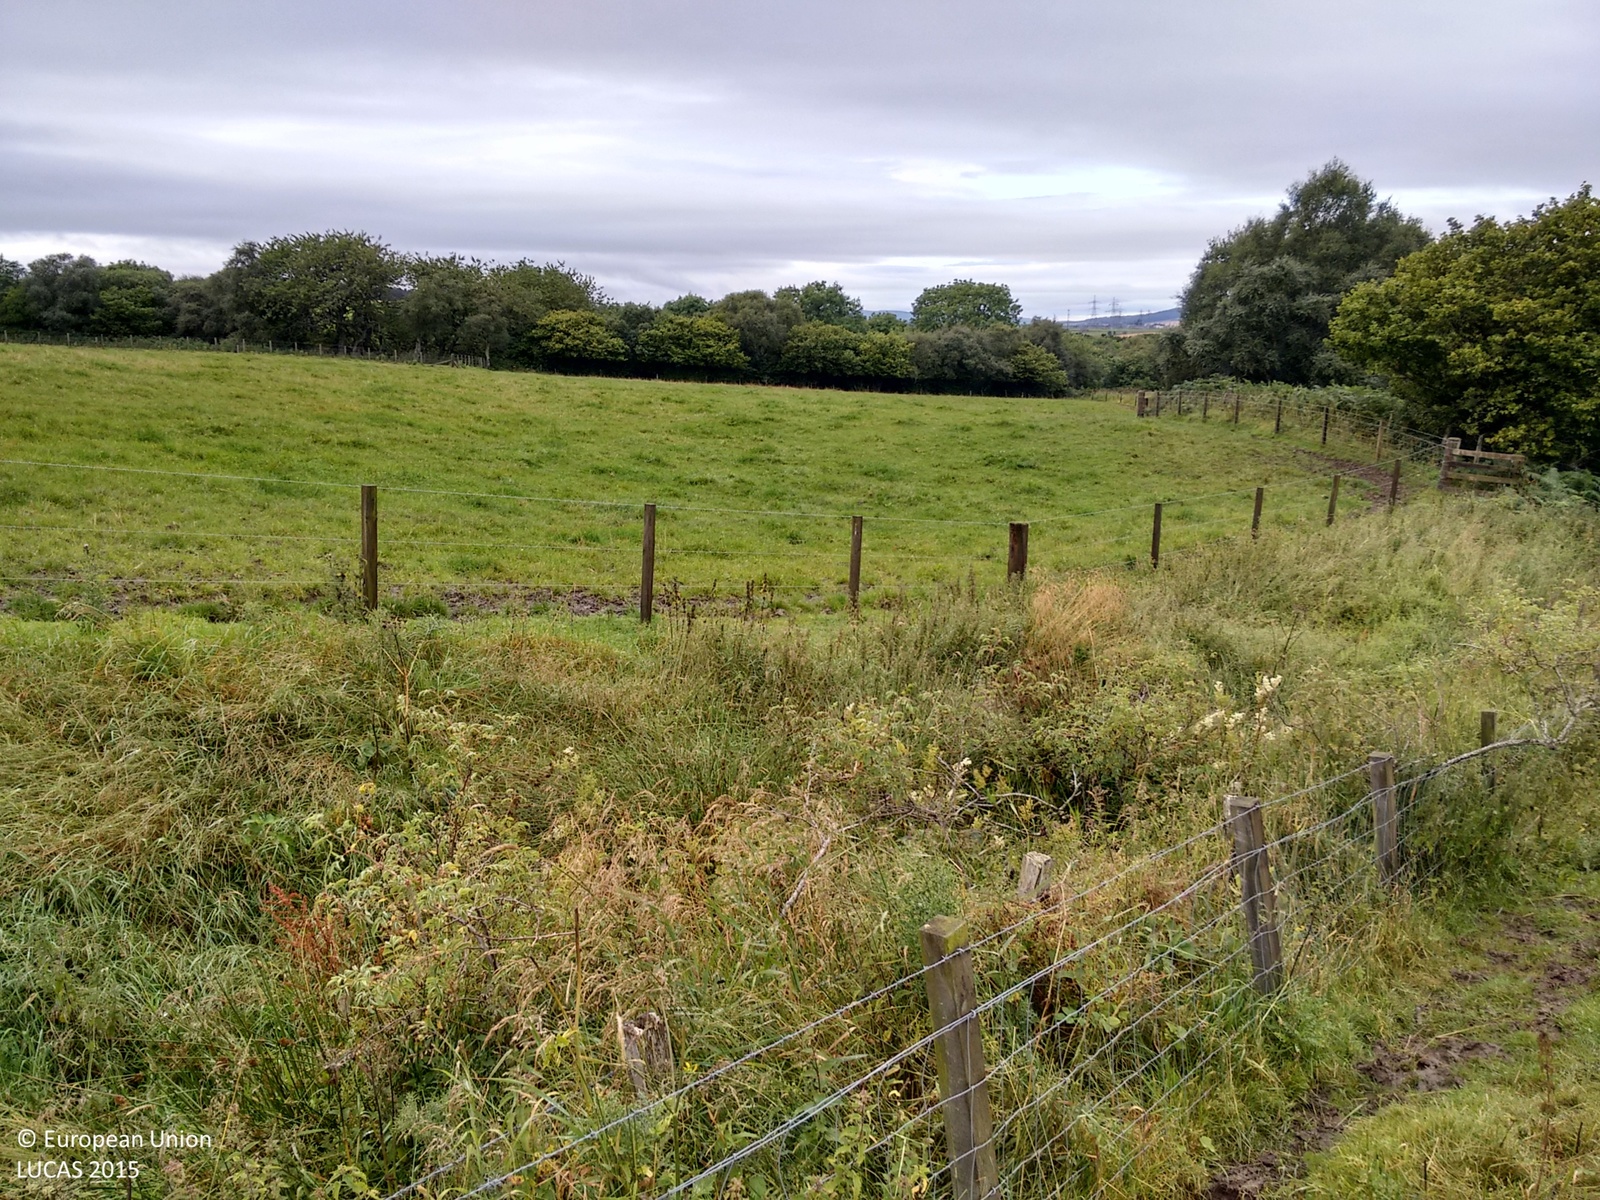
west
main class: Grassland
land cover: Grassland without tree/shrub cover
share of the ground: > 75 %
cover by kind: herbaceous plants 95 %, unconsolidated bare surface 5 %
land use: Agriculture (excluding fallow land and kitchen gardens)
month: September
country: GB
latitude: 57.5391
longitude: -2.9055
